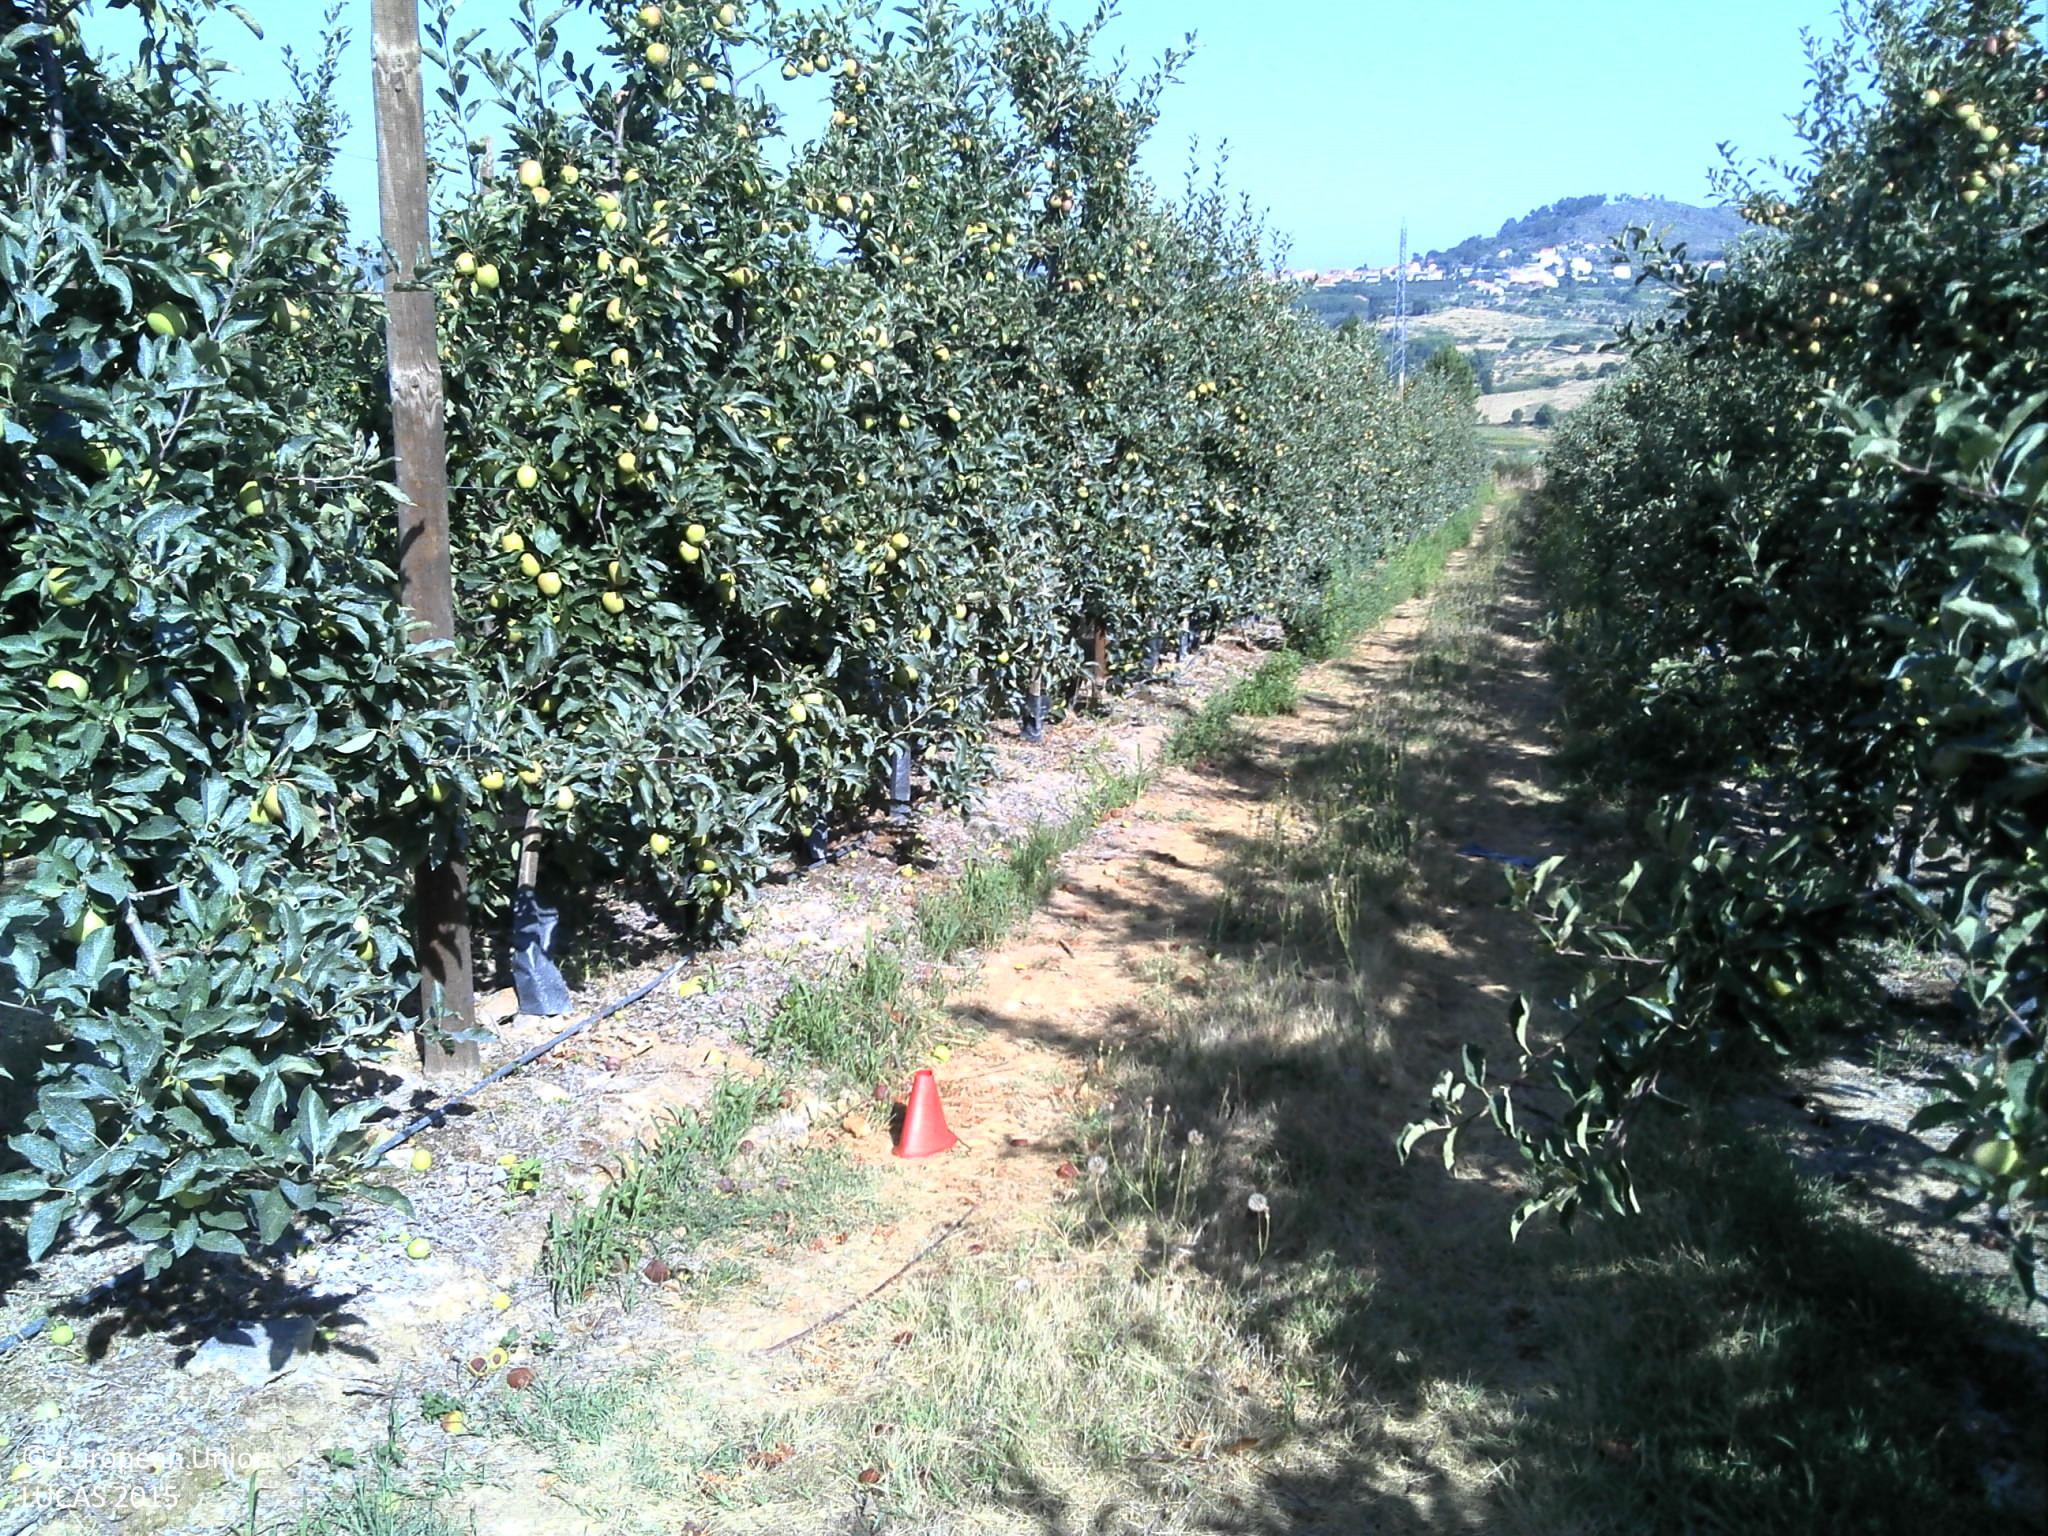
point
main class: Cropland
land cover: Apple fruit
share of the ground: 25 - 50 %
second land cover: Grassland without tree/shrub cover
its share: 10 - 25 %
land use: Agriculture (excluding fallow land and kitchen gardens)
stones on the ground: < 10 %
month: July
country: PT
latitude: 41.0509
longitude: -7.4538
